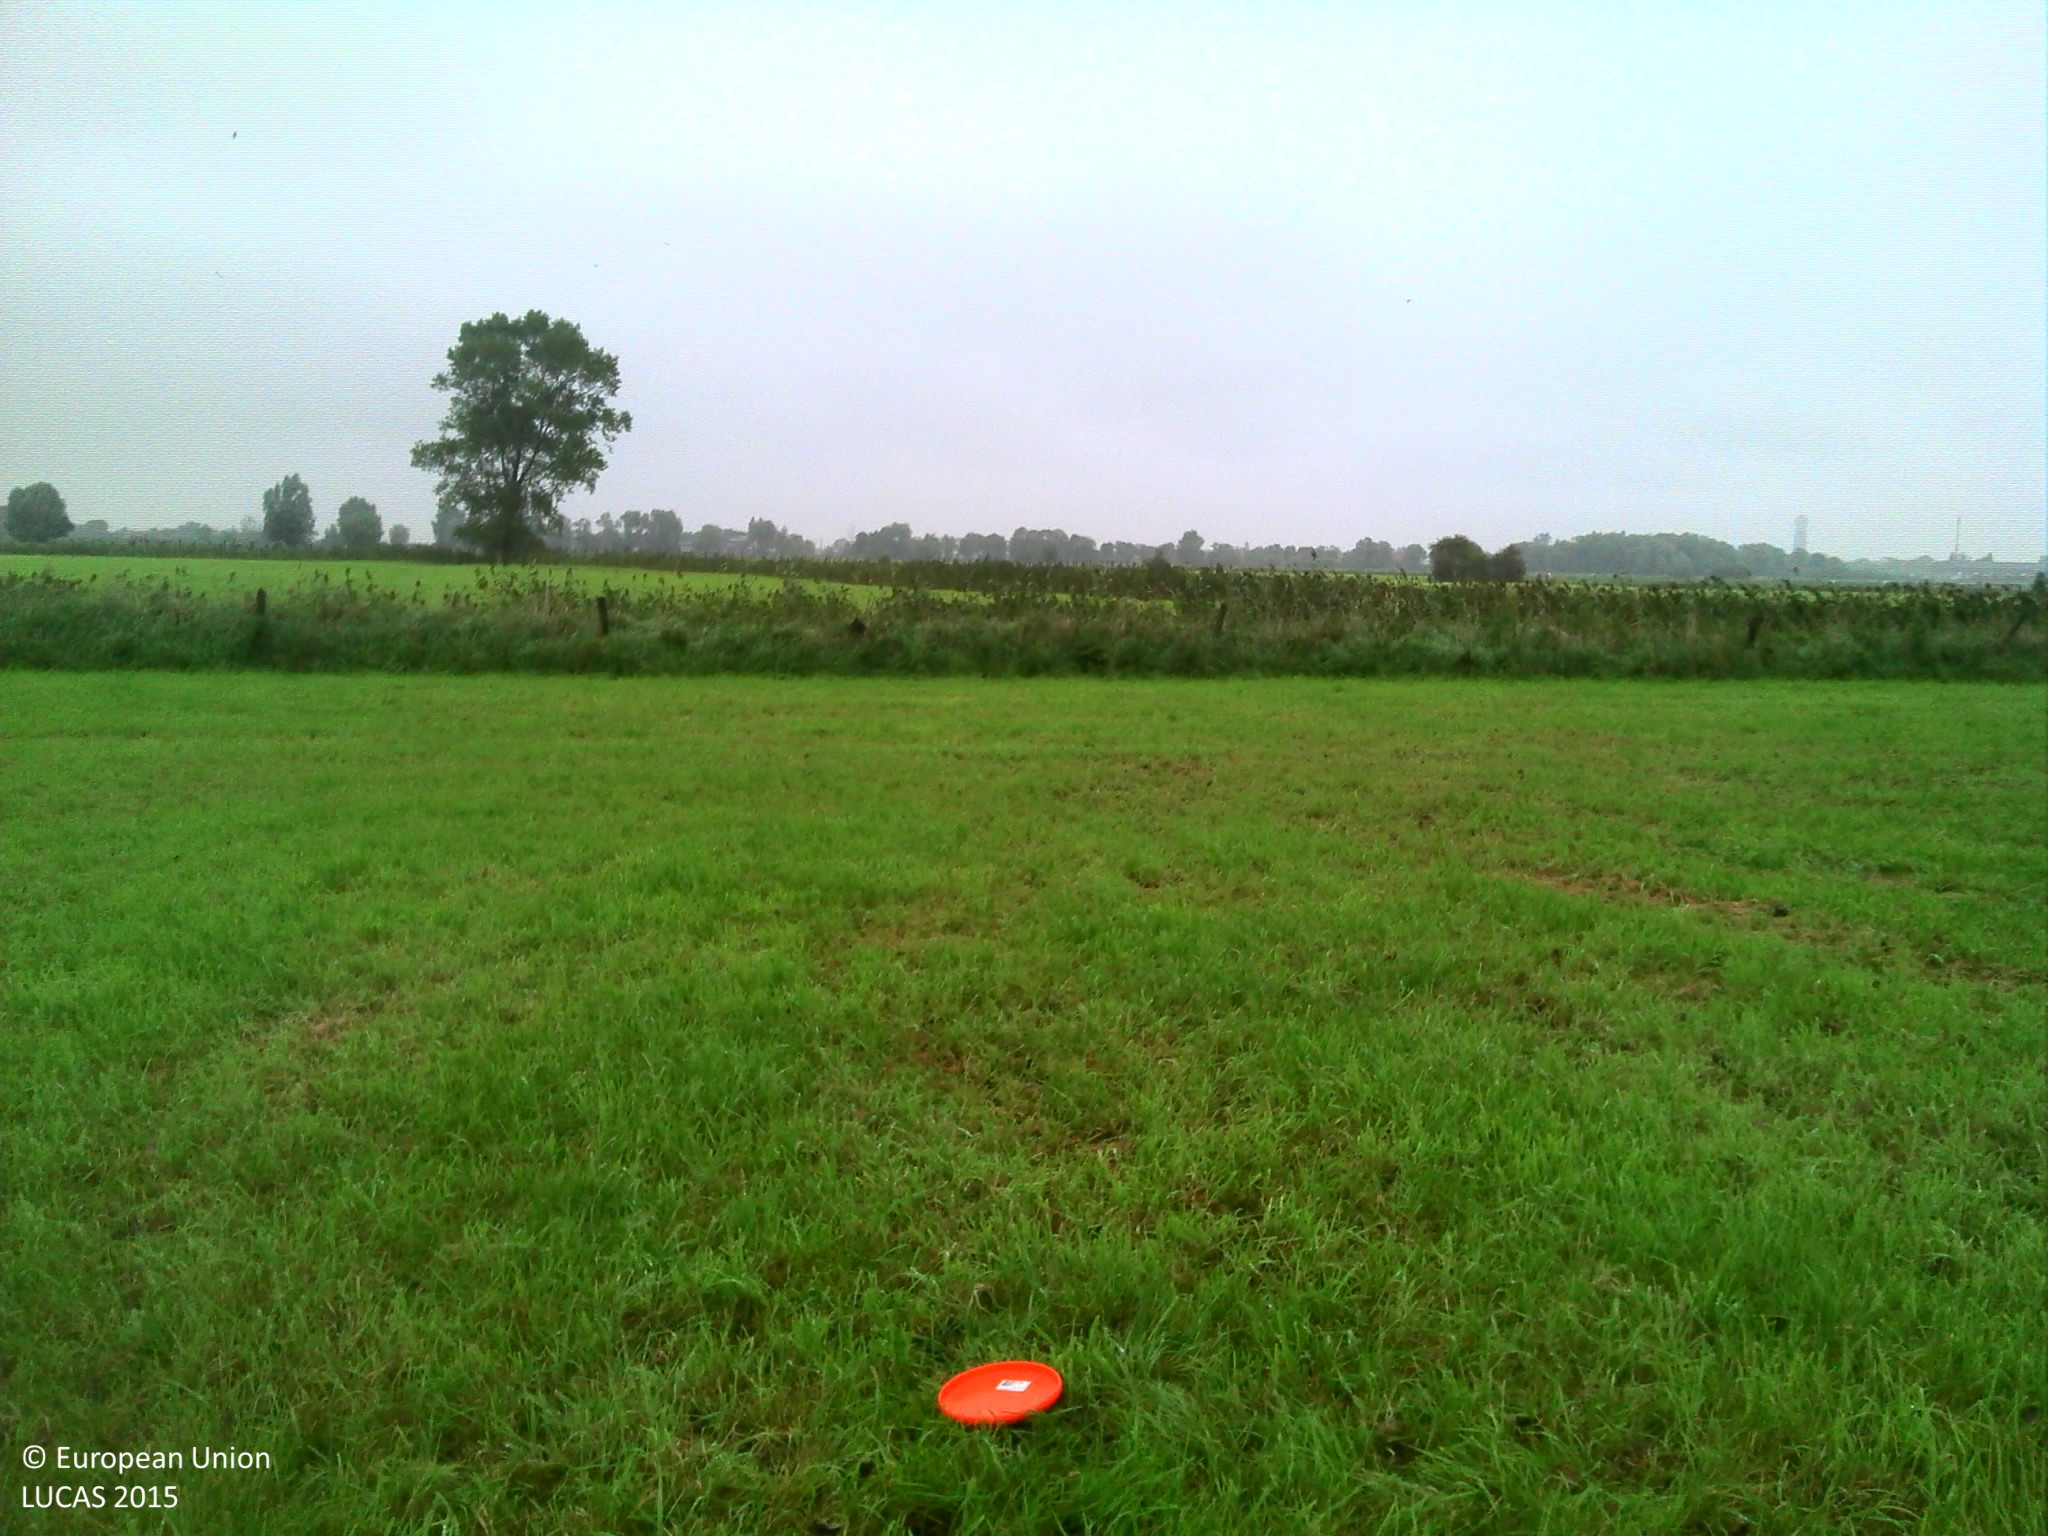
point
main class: Grassland
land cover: Grassland without tree/shrub cover
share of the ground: > 75 %
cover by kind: herbaceous plants 100 %
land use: Agriculture (excluding fallow land and kitchen gardens)
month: October
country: BE
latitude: 51.0066
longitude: 2.8490
